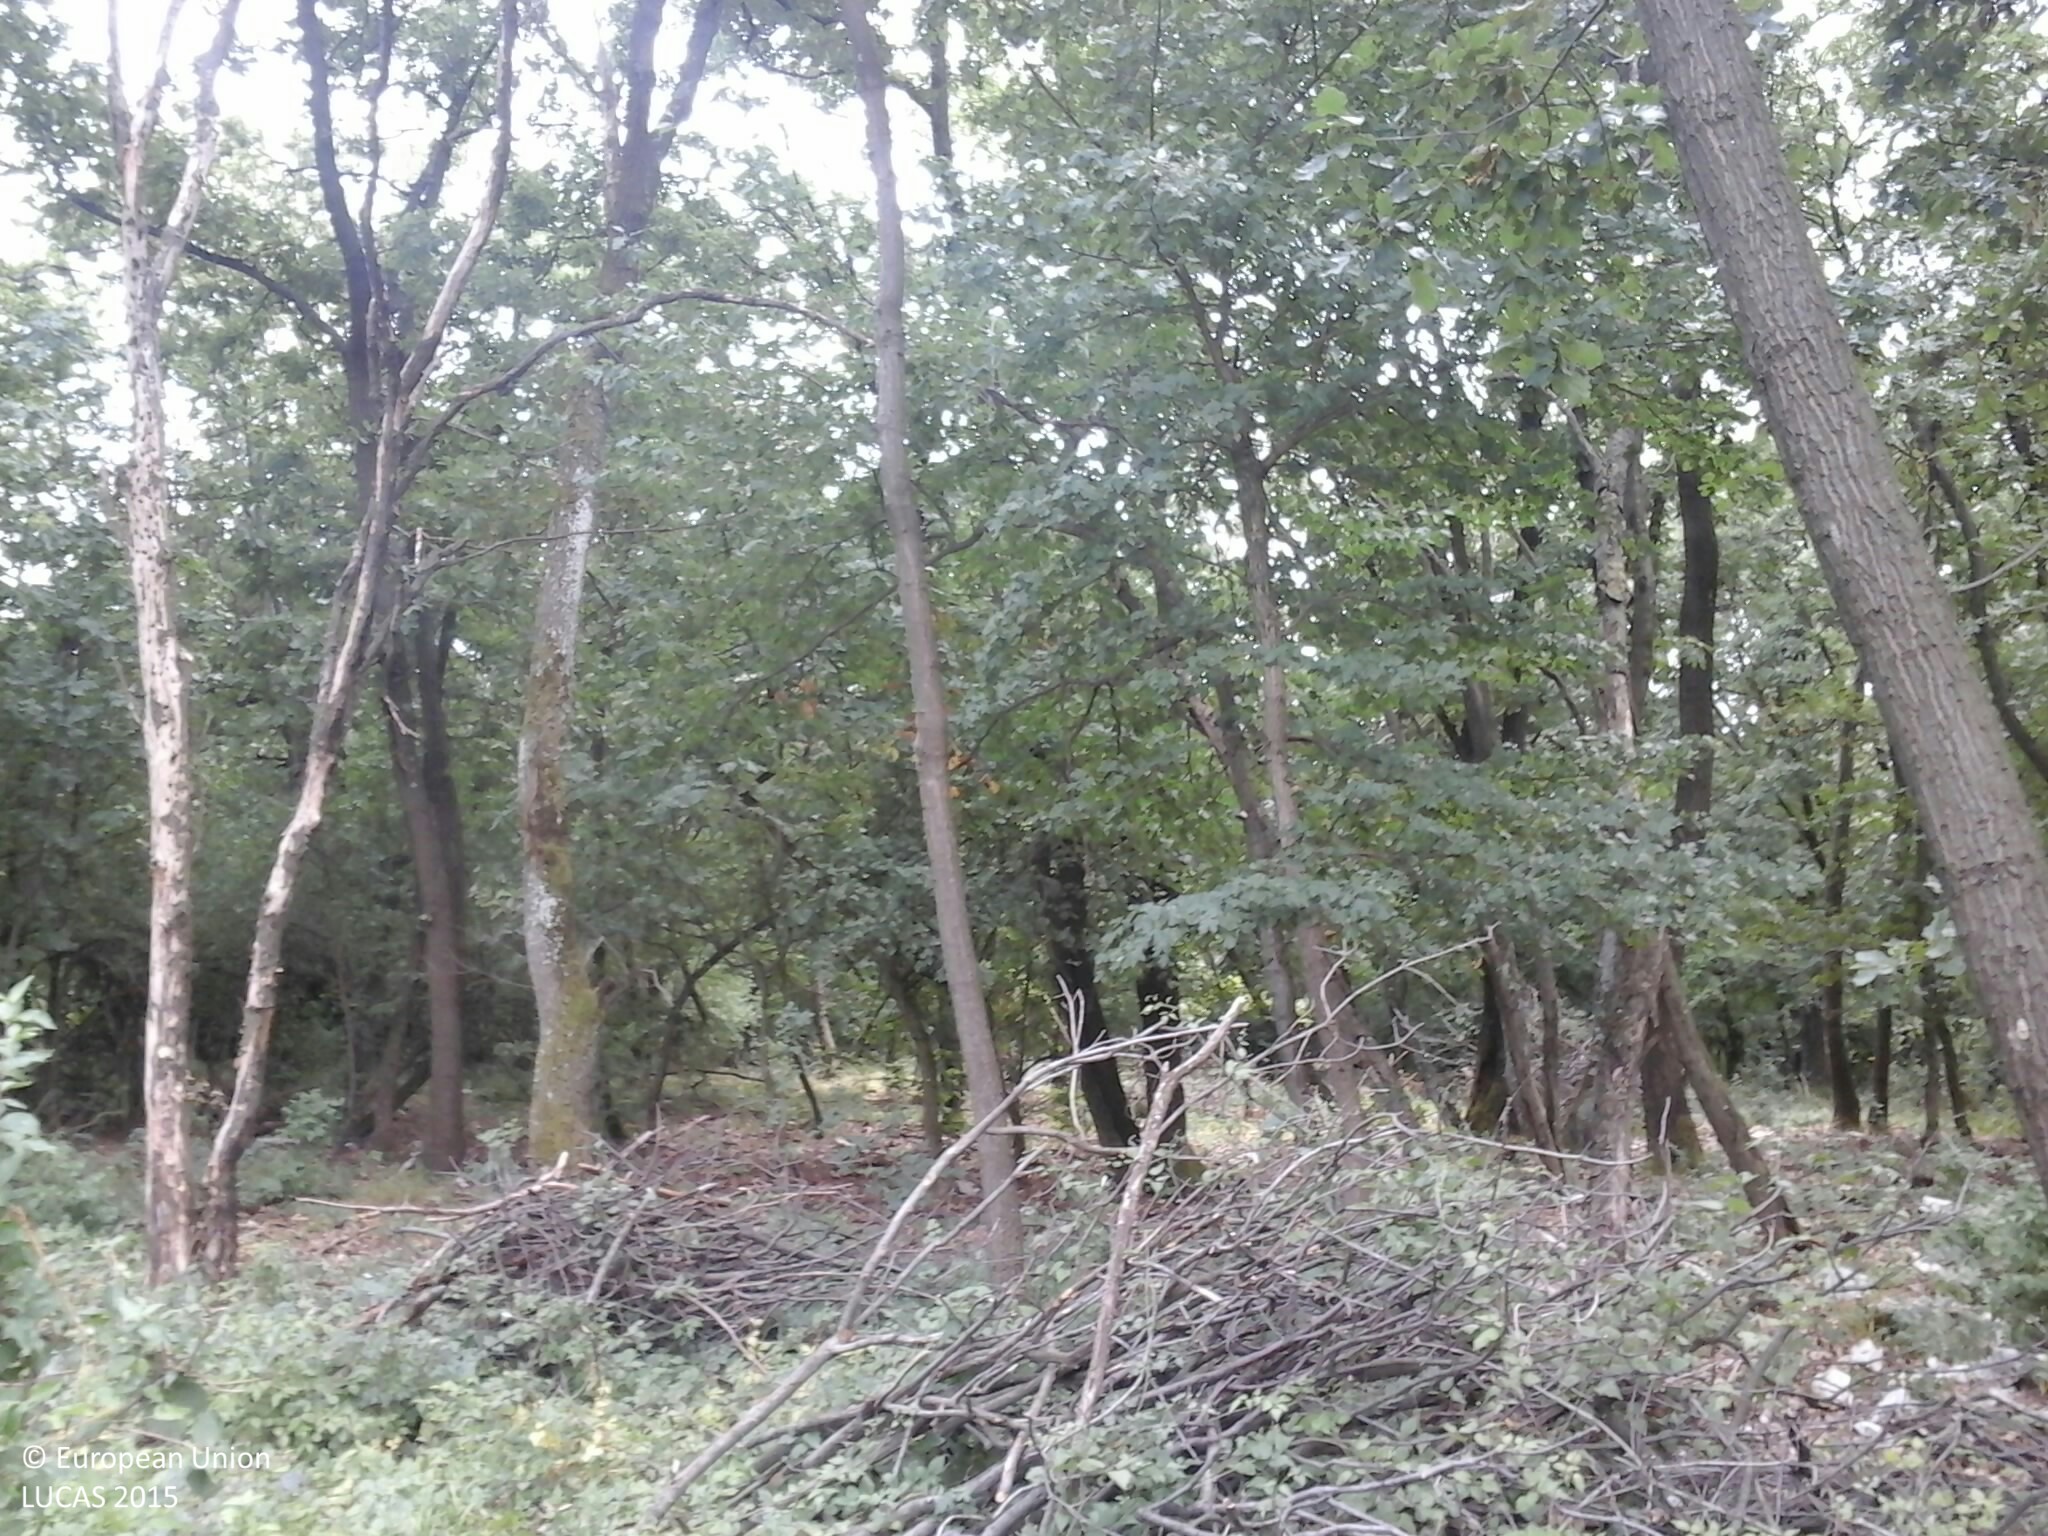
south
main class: Woodland
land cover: Broadleaved woodland
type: acidophilous oak and oak-birch forest
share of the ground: 50 - 75 %
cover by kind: broadleaved forest trees 75 %, herbaceous plants 15 %, consolidated bare surface 10 %
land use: Forestry
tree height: > 5 m
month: July
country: HU
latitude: 46.9563
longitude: 17.7473
